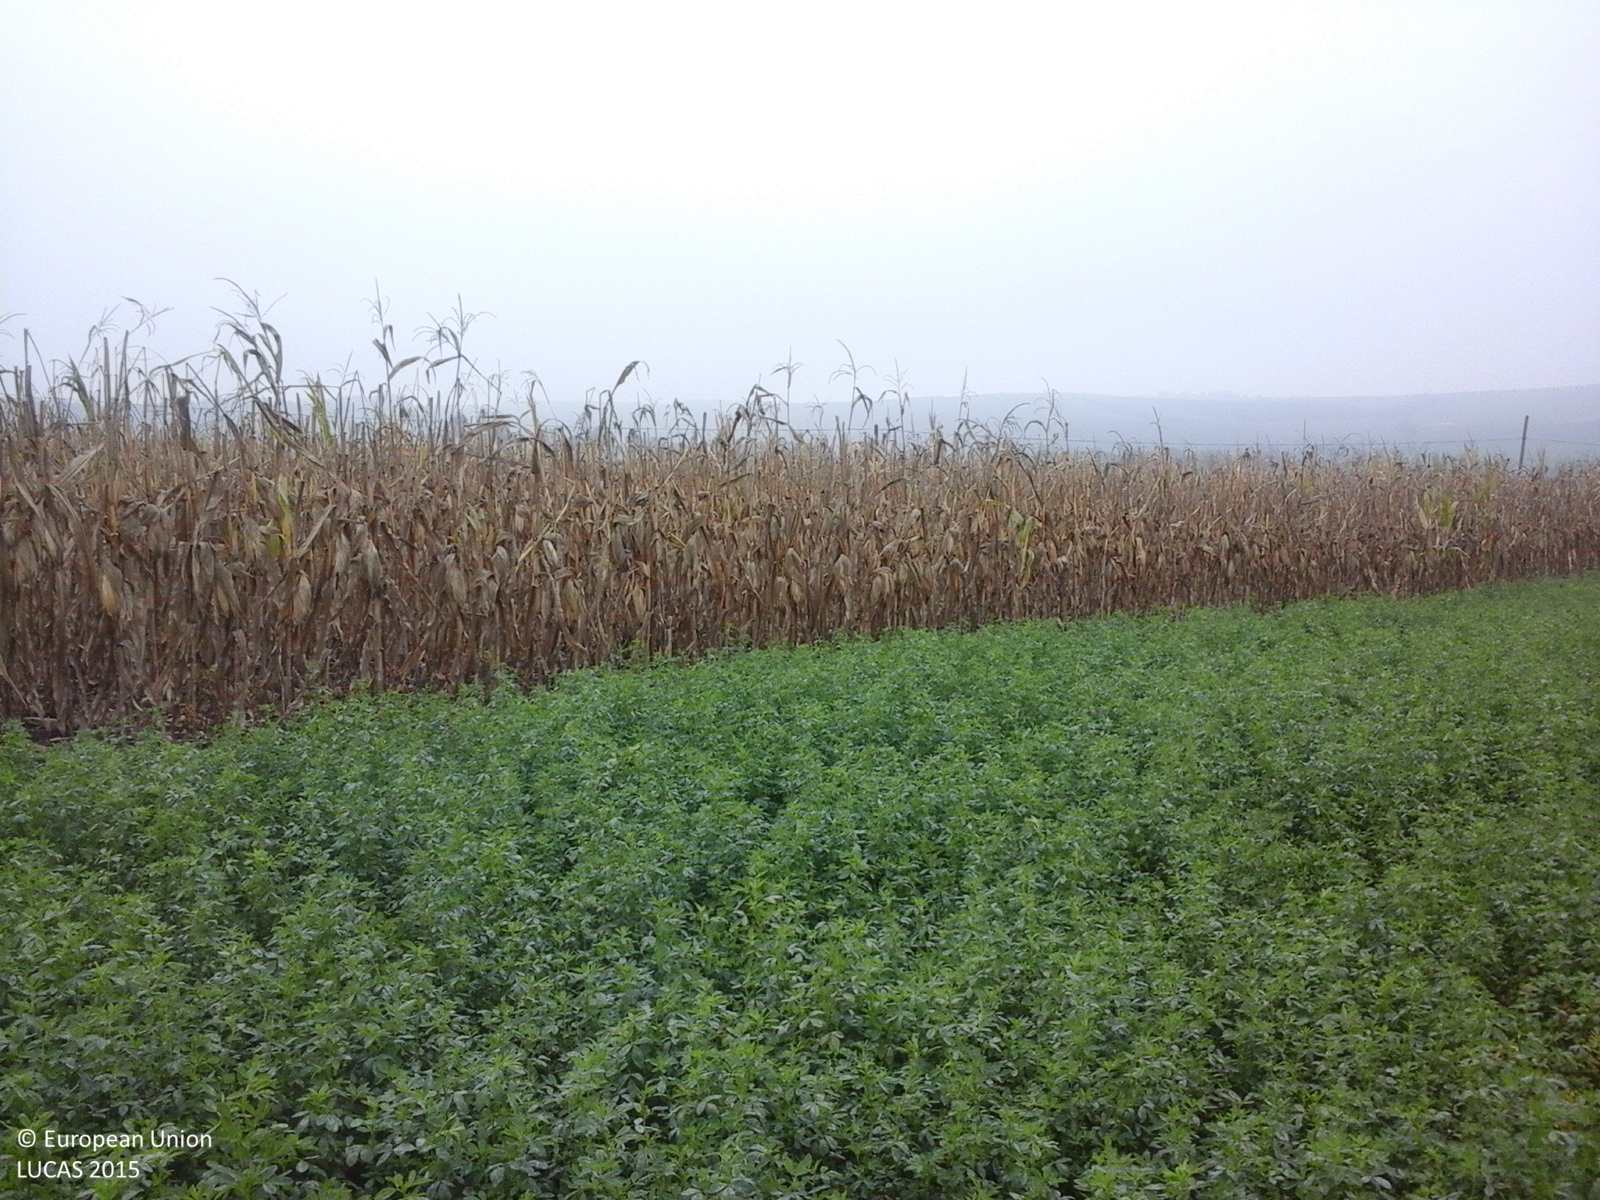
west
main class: Cropland
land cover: Lucerne
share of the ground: > 75 %
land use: Agriculture (excluding fallow land and kitchen gardens)
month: October
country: RO
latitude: 46.5662
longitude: 24.2103
